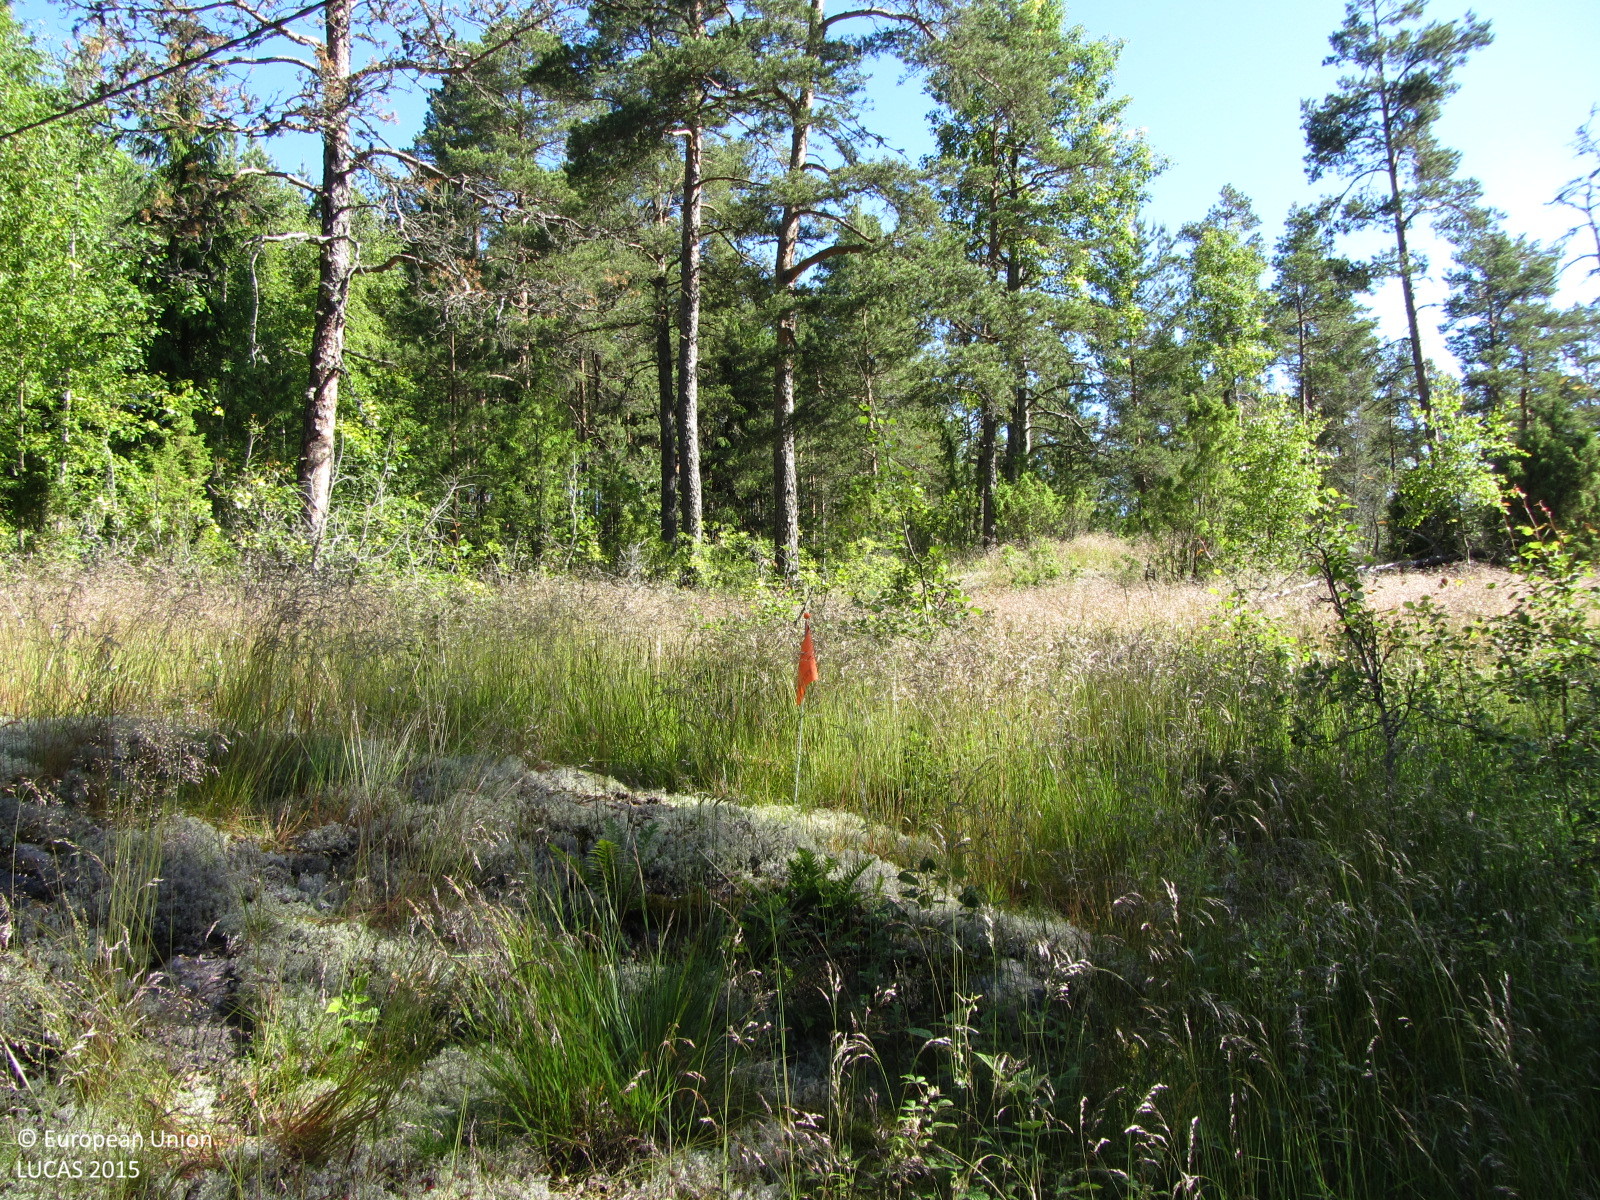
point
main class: Grassland
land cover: Grassland with sparse tree/shrub cover
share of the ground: 50 - 75 %
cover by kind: herbaceous plants 70 %, lichens and mosses 25 %, broadleaved forest trees 5 %
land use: Forestry
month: July
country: FI
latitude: 60.0914
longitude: 23.1546
